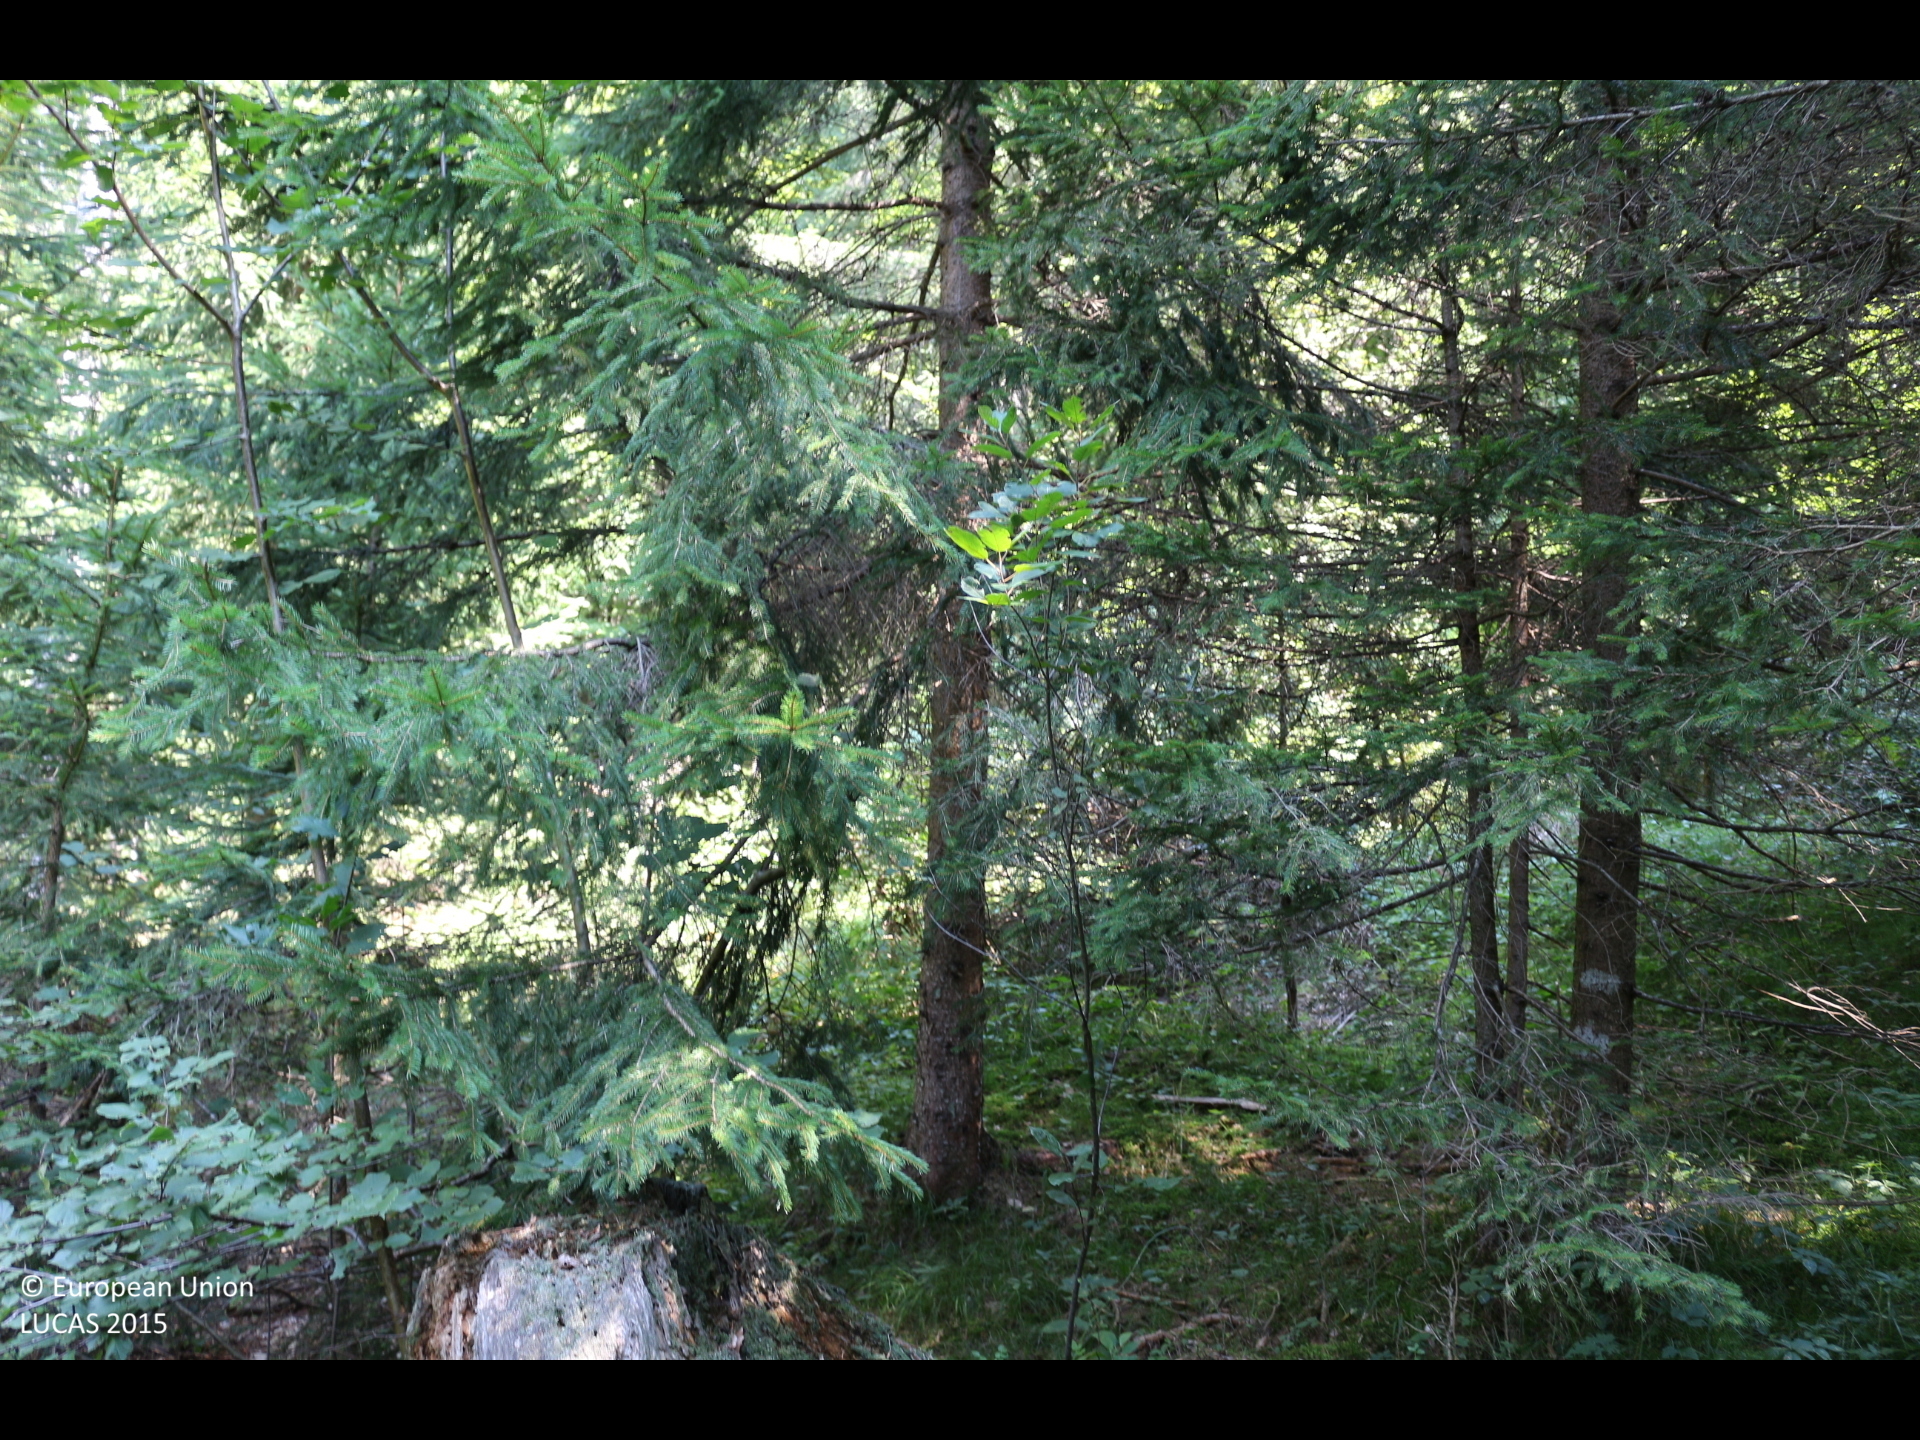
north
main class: Woodland
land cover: Spruce dominated mixed woodland
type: alpine coniferous forest
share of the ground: > 75 %
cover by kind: coniferous forest trees 65 %, broadleaved forest trees 25 %, shrubs 5 %, herbaceous plants 5 %
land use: Forestry
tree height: > 5 m
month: August
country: AT
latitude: 46.6795
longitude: 13.2787
